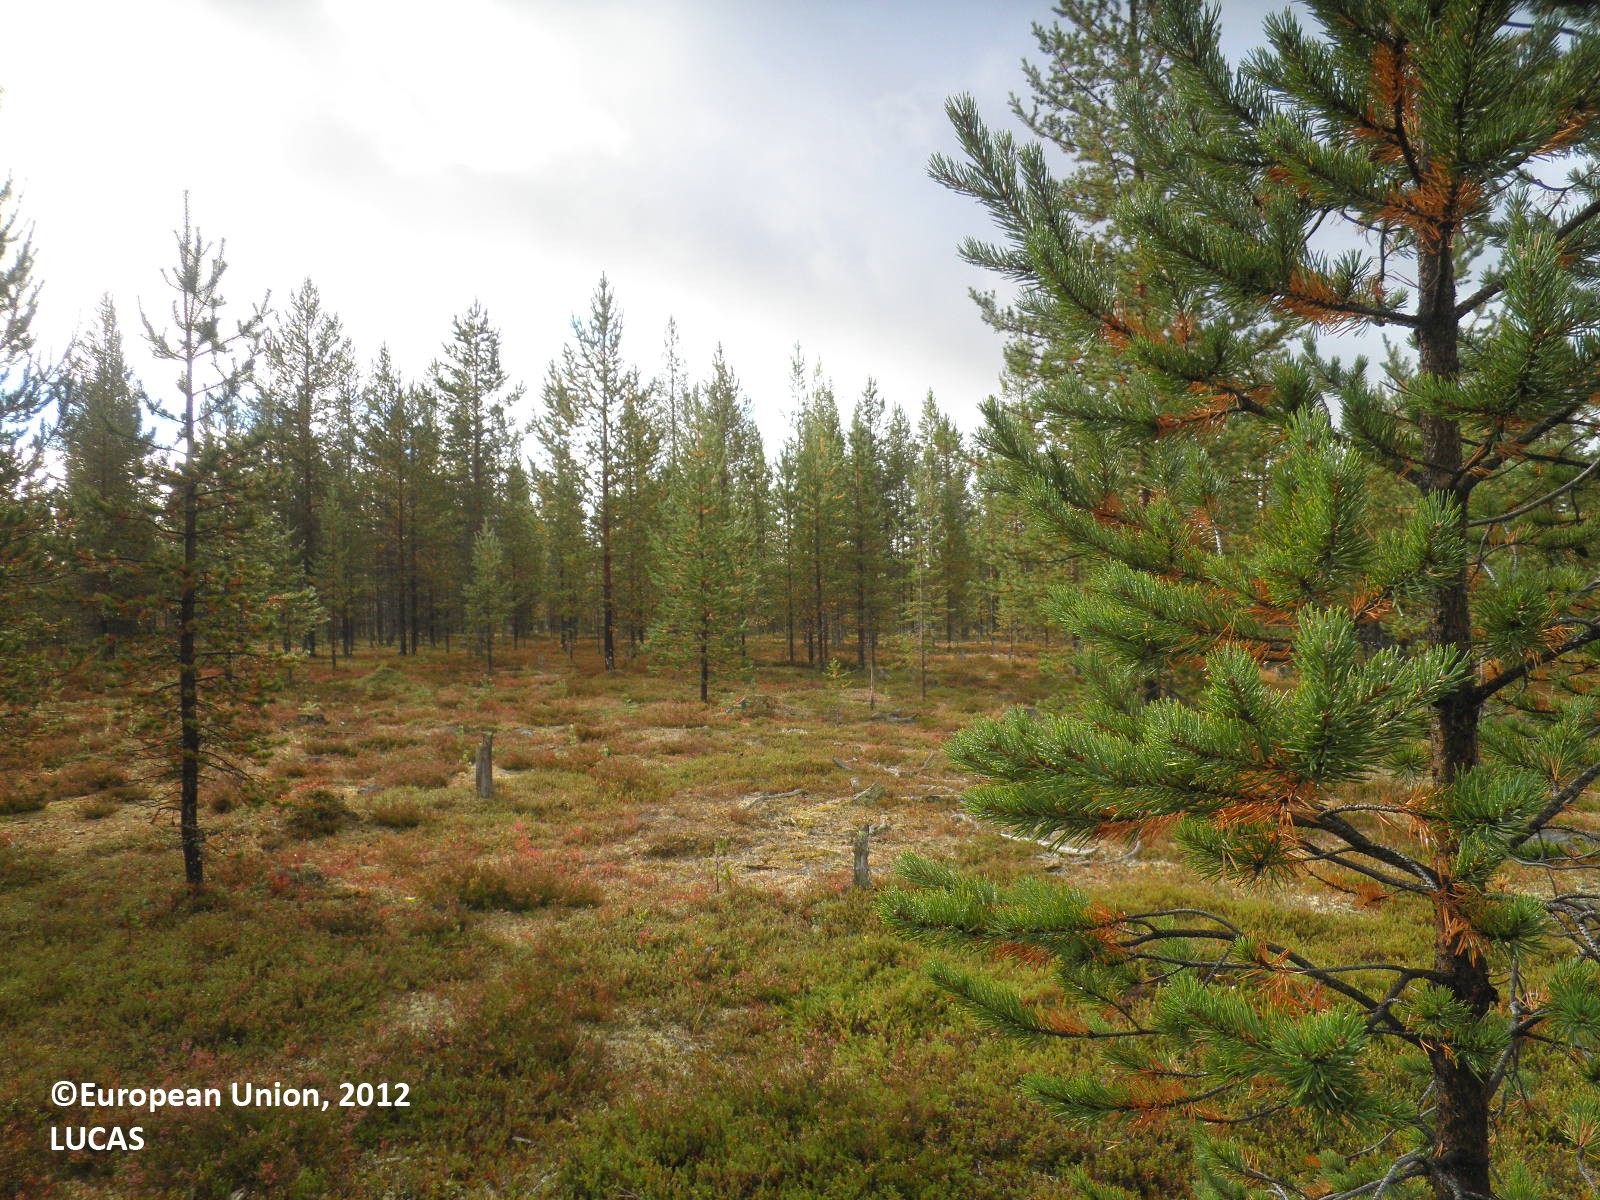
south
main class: Woodland
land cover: Pine dominated coniferous woodland
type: boreal forest
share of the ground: 10 - 25 %
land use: Forestry
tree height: > 5 m
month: September
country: FI
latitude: 67.4622
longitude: 28.3846
